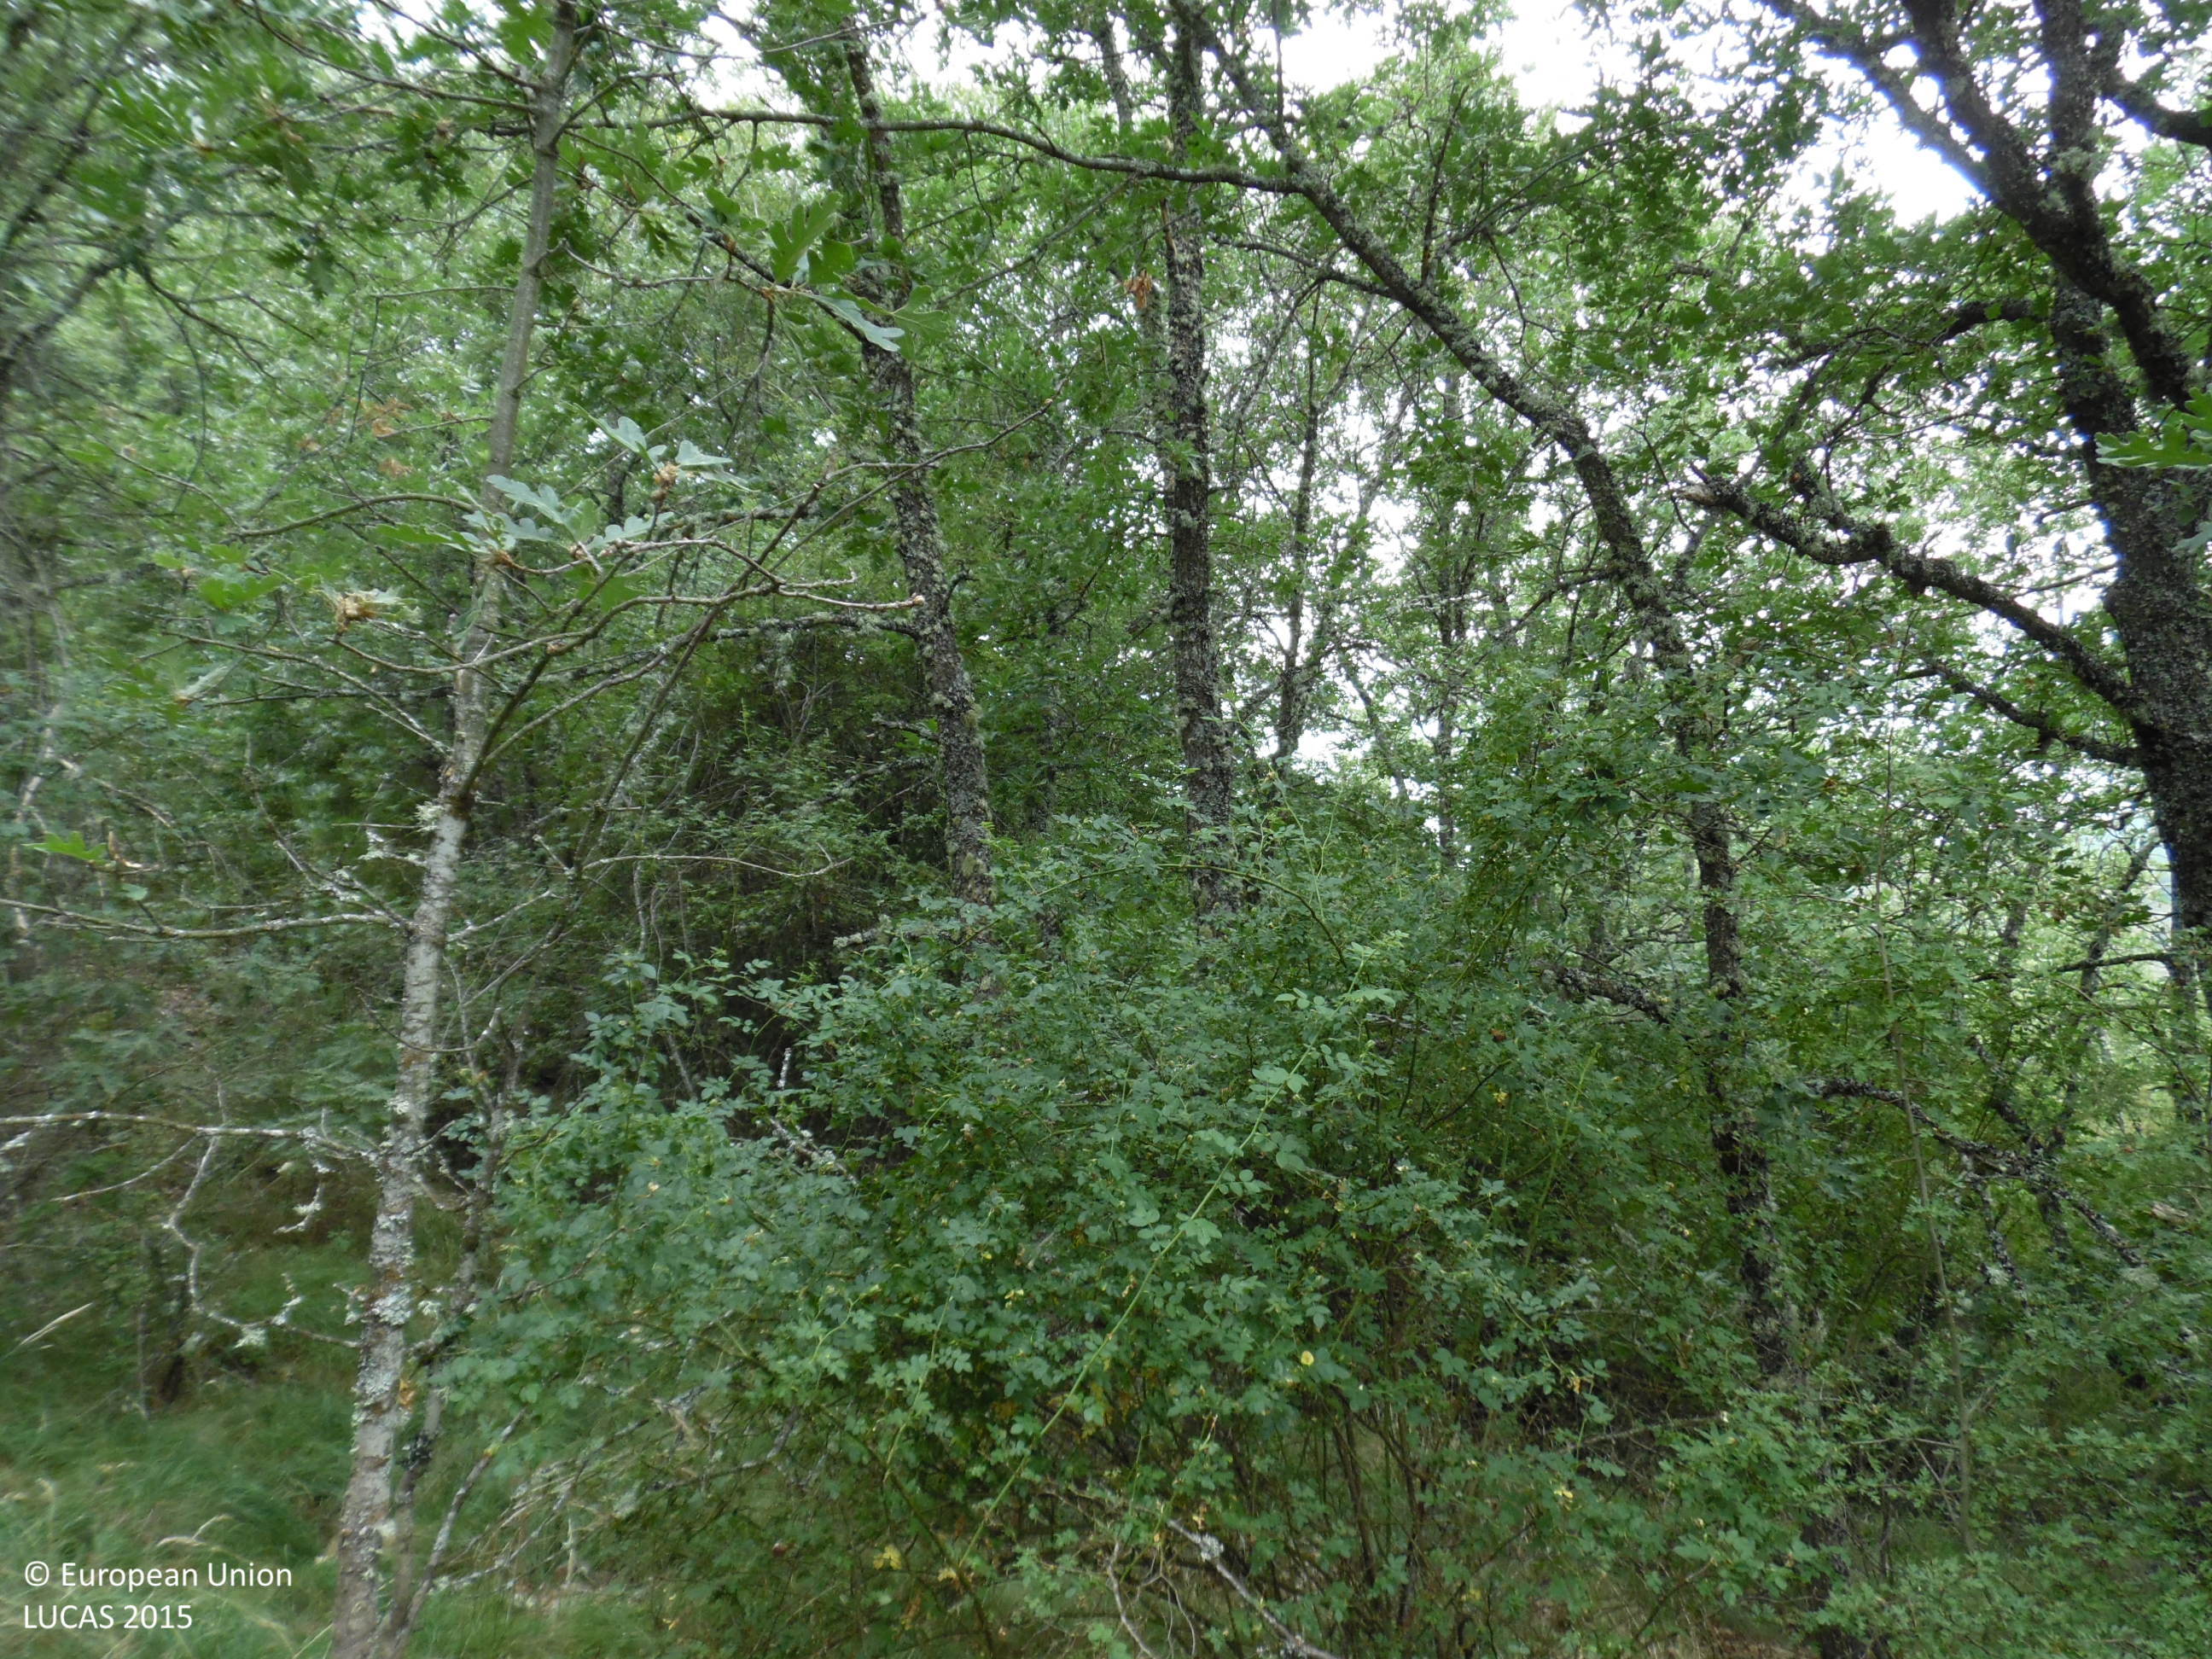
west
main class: Woodland
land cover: Broadleaved woodland
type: thermophilous deciduous forest
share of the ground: > 75 %
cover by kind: broadleaved forest trees 95 %, shrubs 5 %
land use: Forestry
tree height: > 5 m
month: July
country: ES
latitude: 42.7199
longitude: -5.8450
